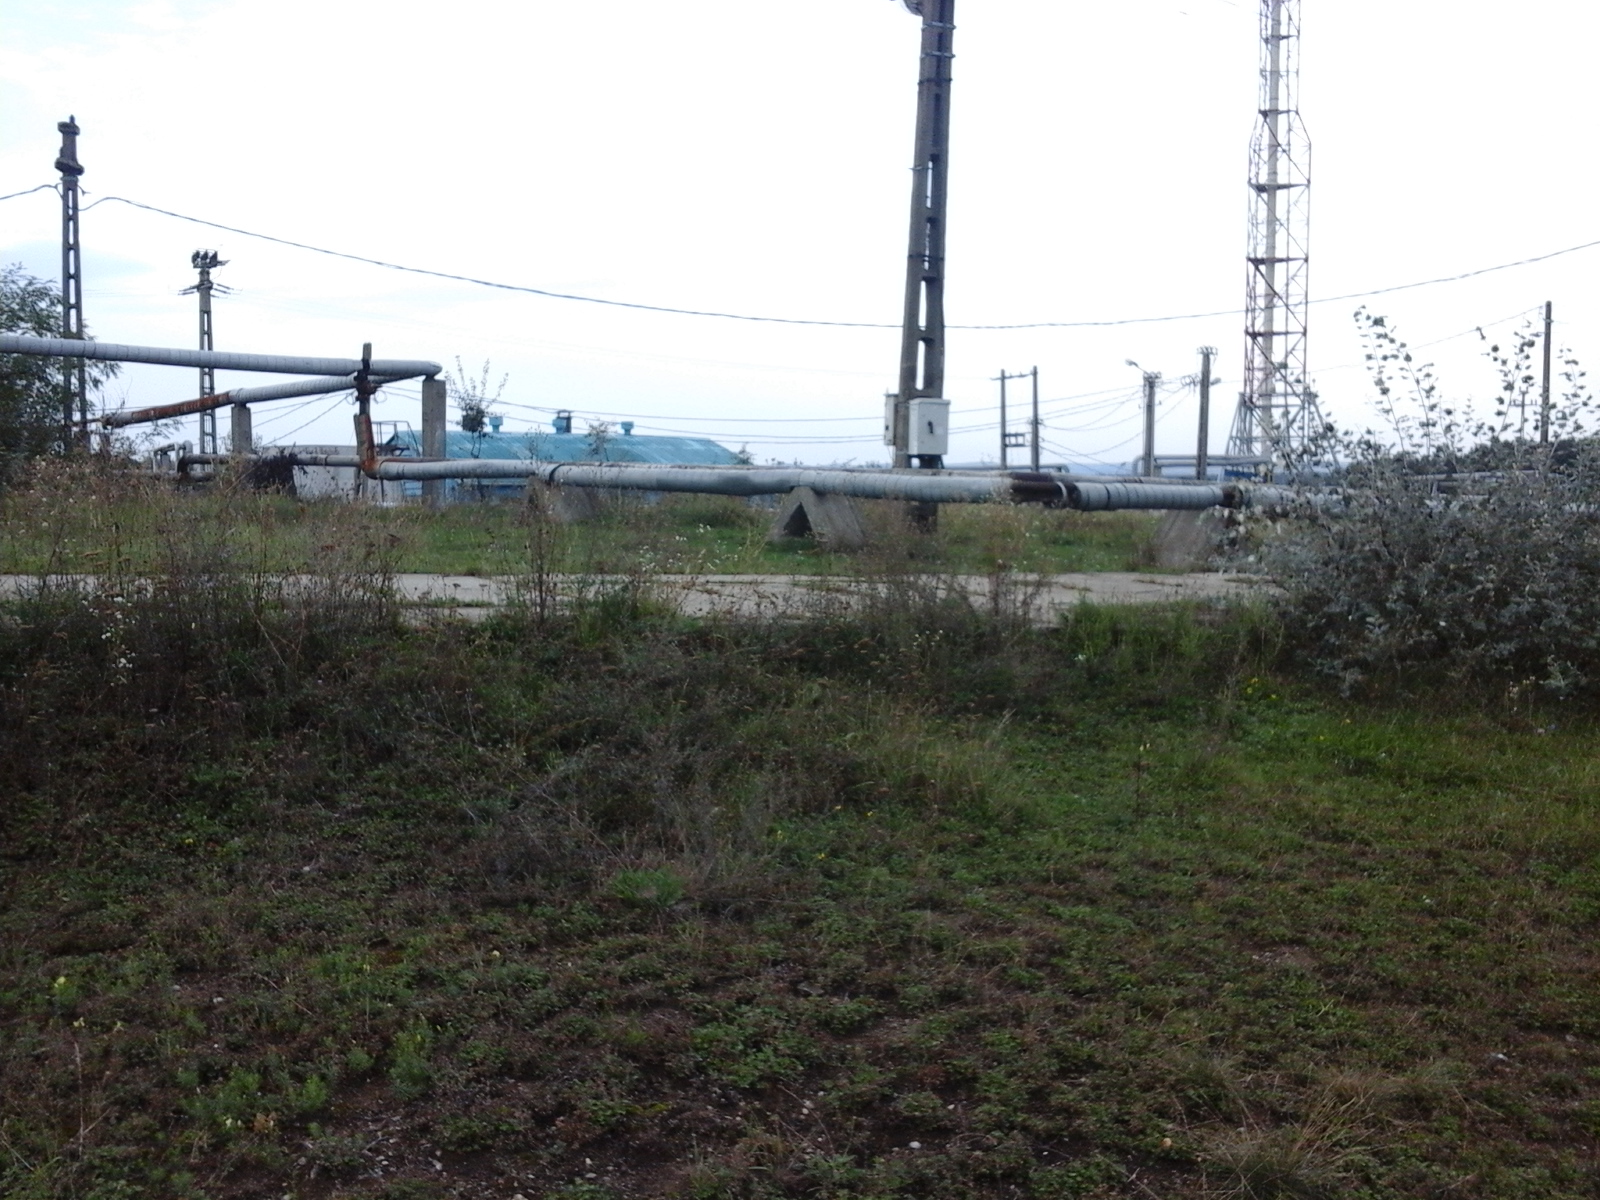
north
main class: Grassland
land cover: Grassland without tree/shrub cover
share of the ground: > 75 %
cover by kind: herbaceous plants 100 %
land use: Agriculture (excluding fallow land and kitchen gardens)
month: September
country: RO
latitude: 47.2550
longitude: 22.4899
